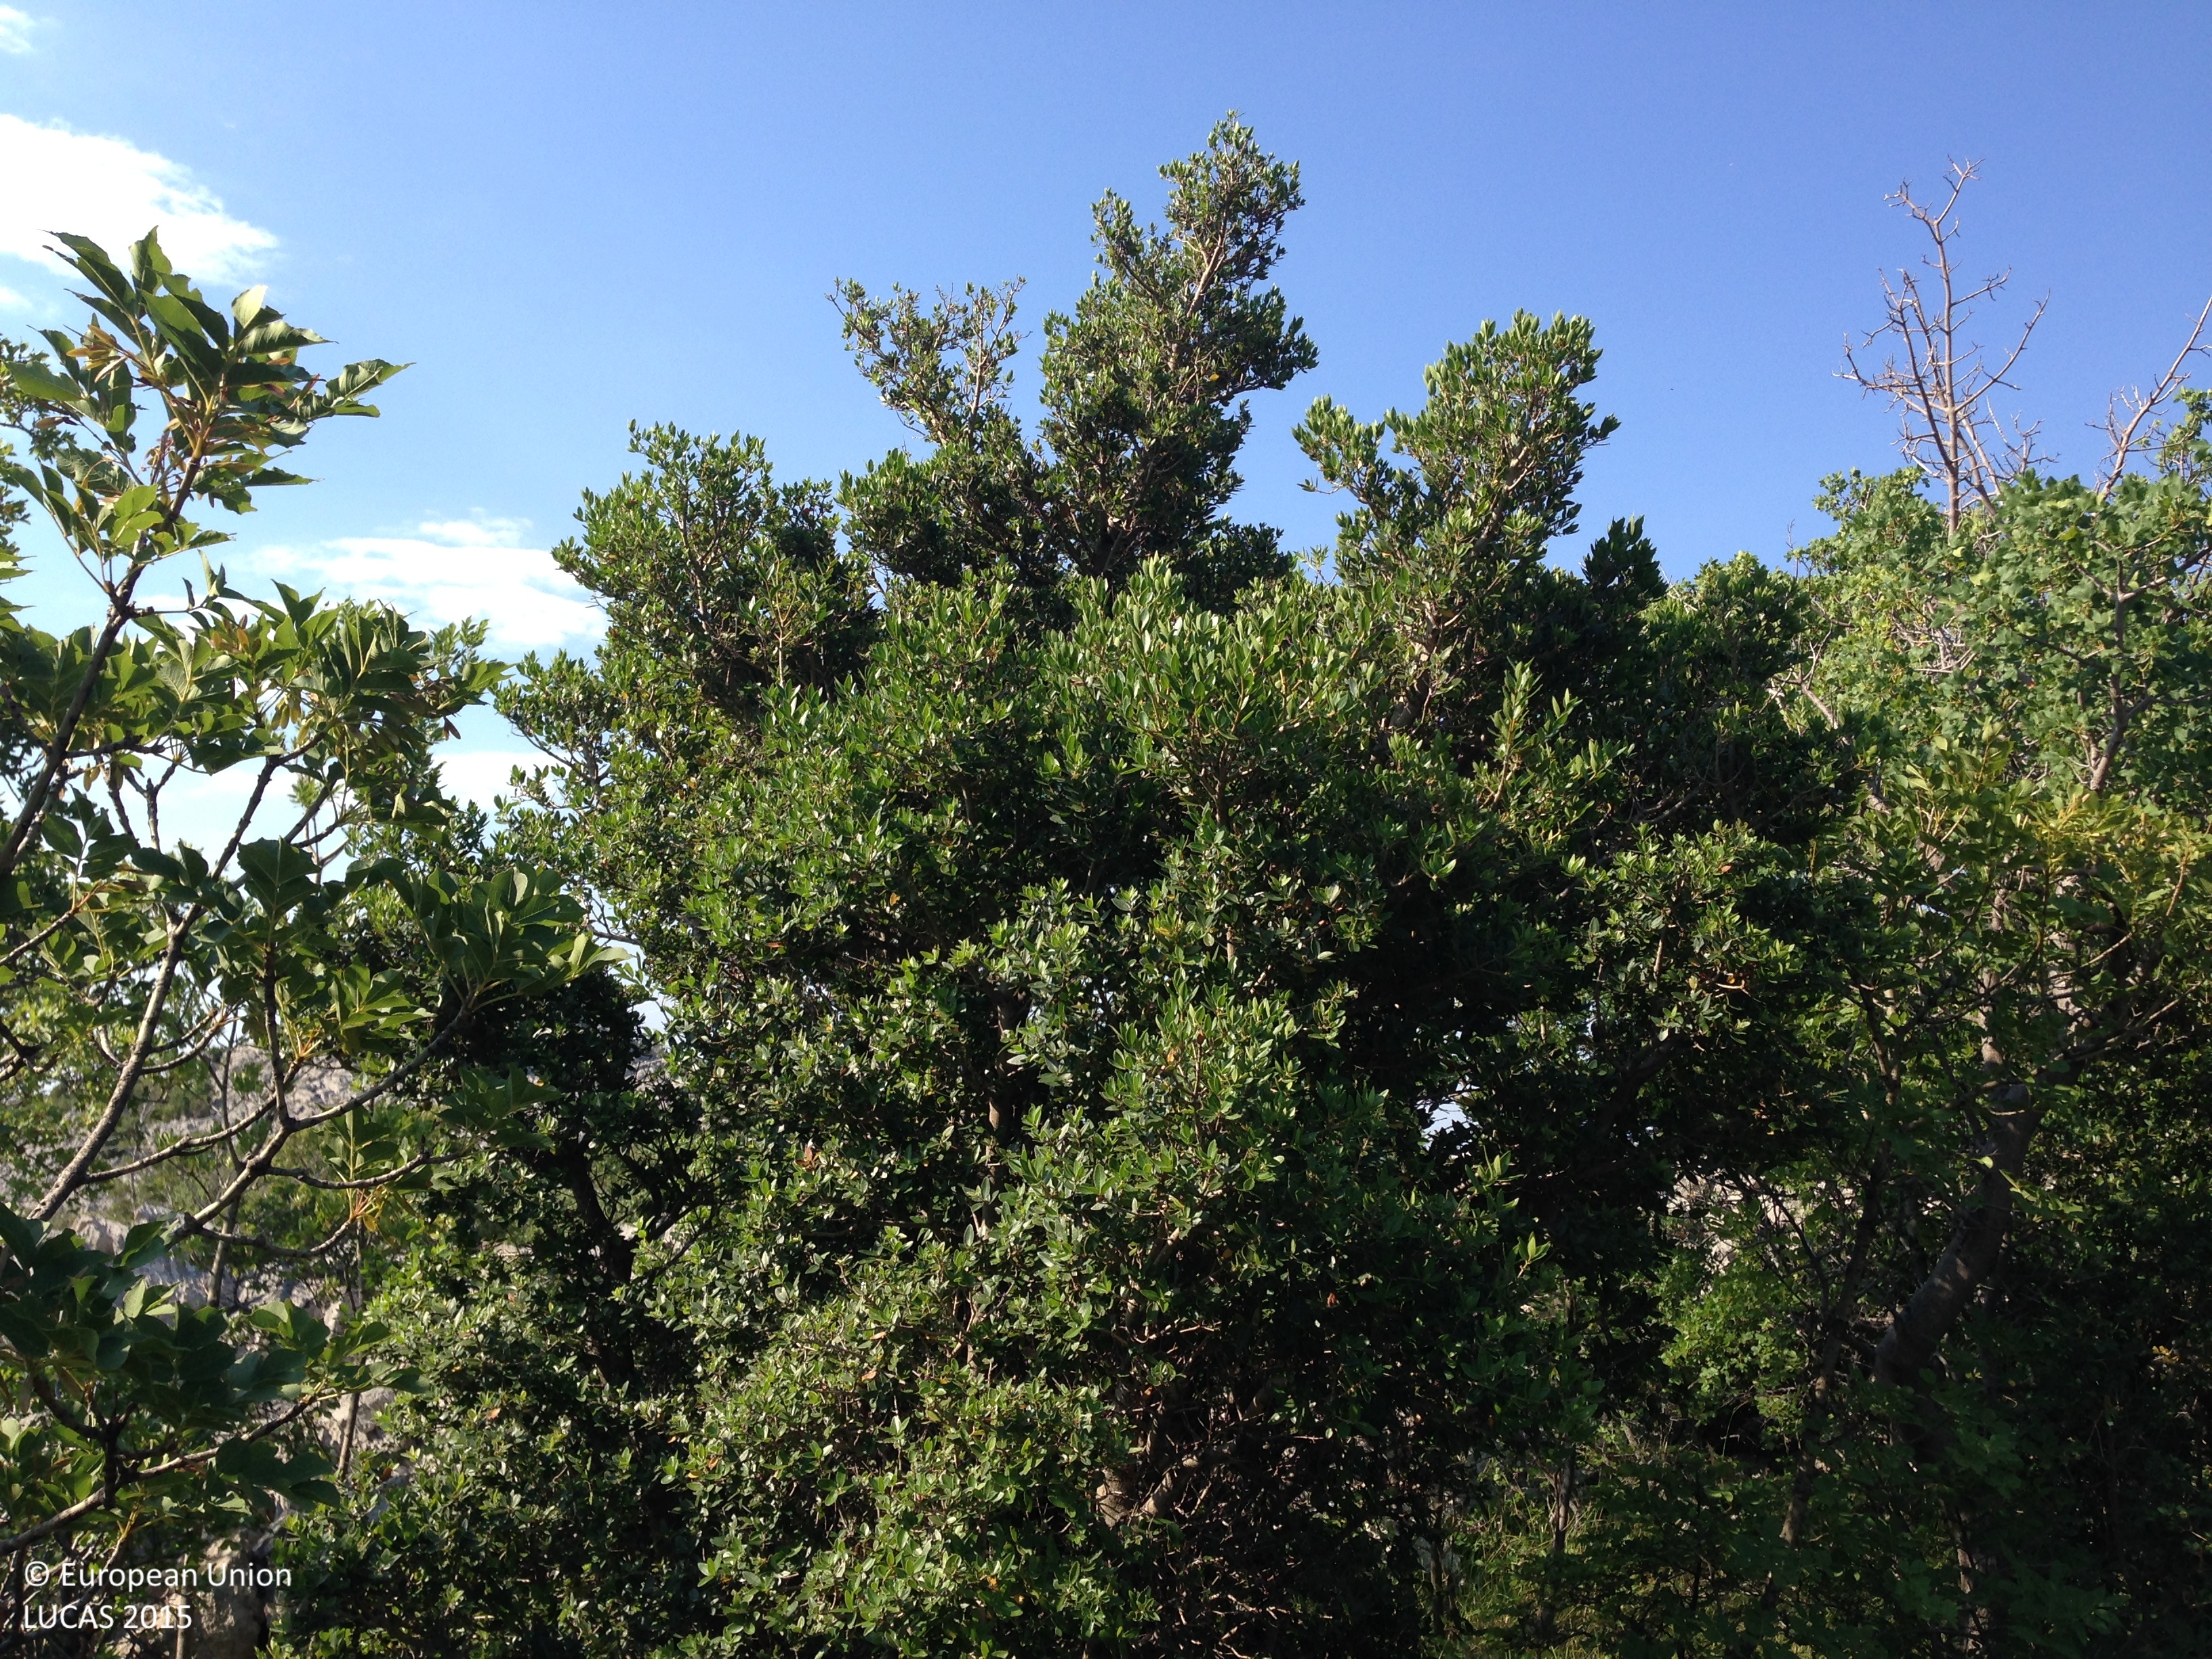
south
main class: Woodland
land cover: Other mixed woodland
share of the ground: 25 - 50 %
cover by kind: unconsolidated bare surface 30 %, herbaceous plants 20 %, broadleaved forest trees 15 %, shrubs 15 %, coniferous forest trees 10 %, consolidated bare surface 10 %
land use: Semi-natural and natural areas not in use
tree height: < 5 m
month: July
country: HR
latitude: 44.5917
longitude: 14.9942
